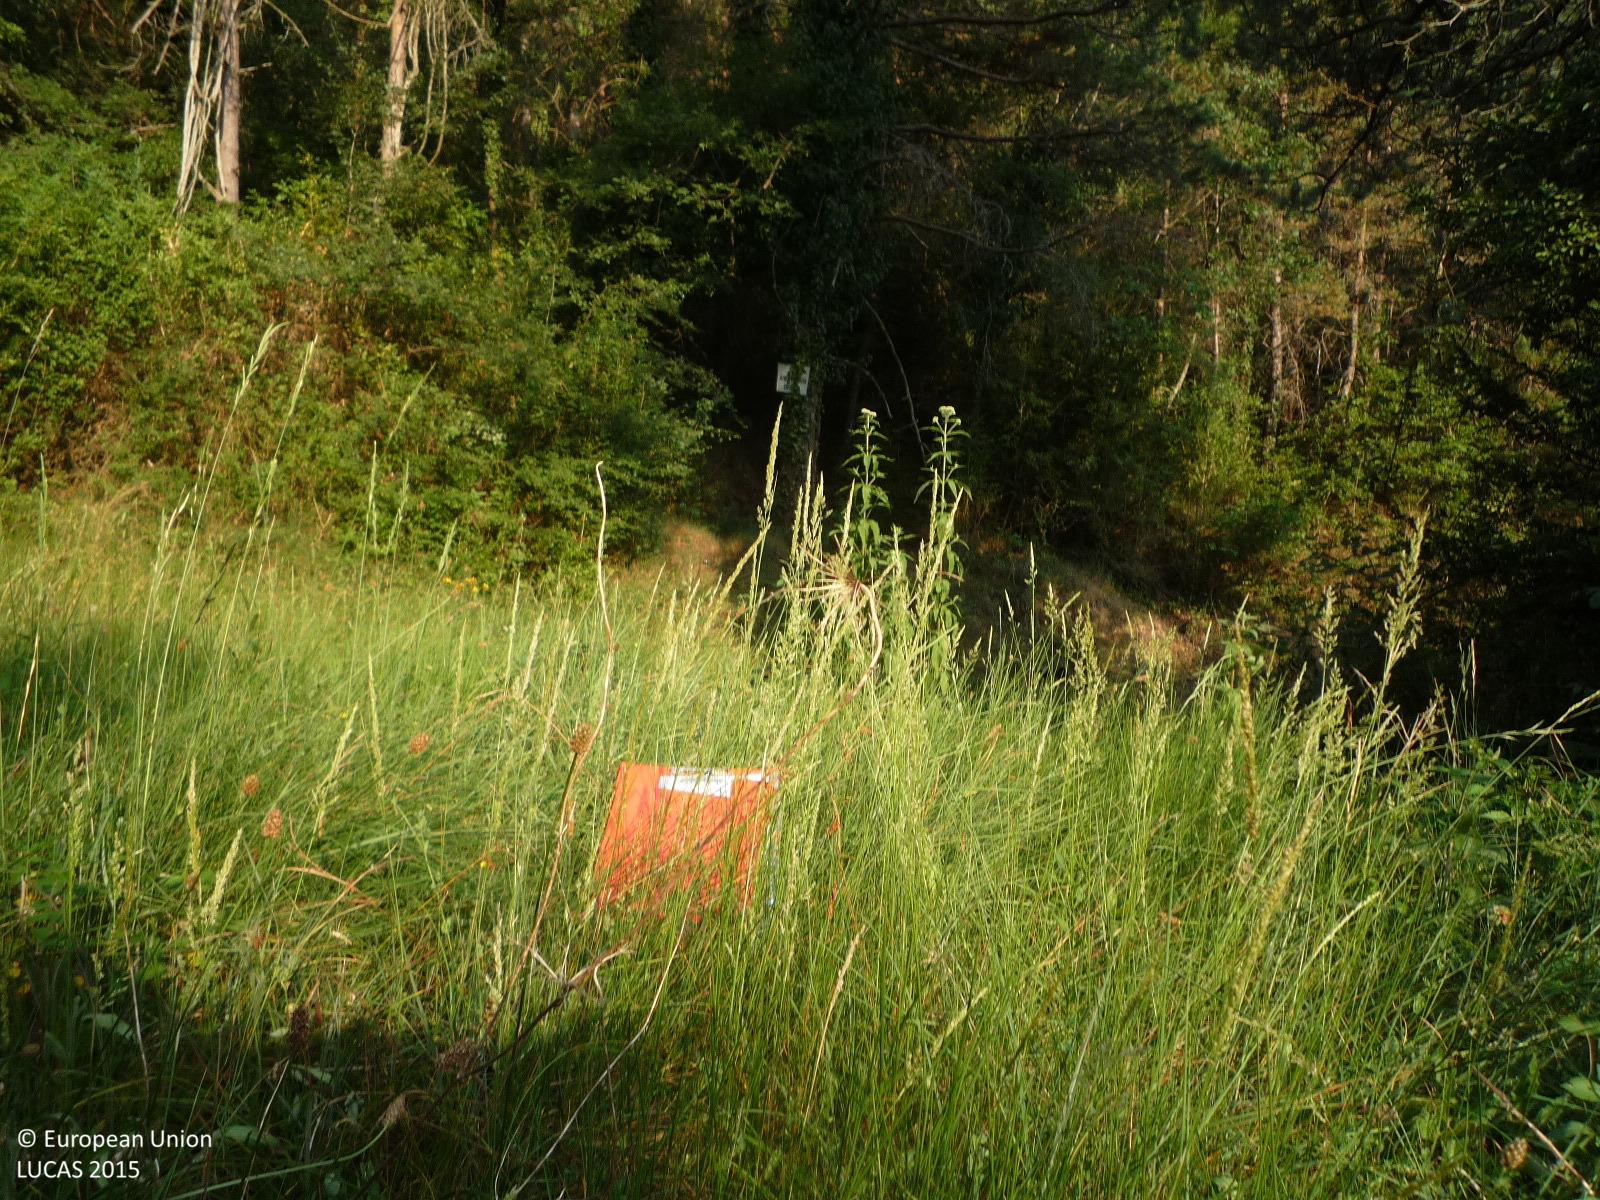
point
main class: Grassland
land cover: Grassland with sparse tree/shrub cover
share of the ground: > 75 %
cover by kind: herbaceous plants 95 %, broadleaved forest trees 5 %
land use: Agriculture (excluding fallow land and kitchen gardens)
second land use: Forestry
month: July
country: ES
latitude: 42.0765
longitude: 2.1450
